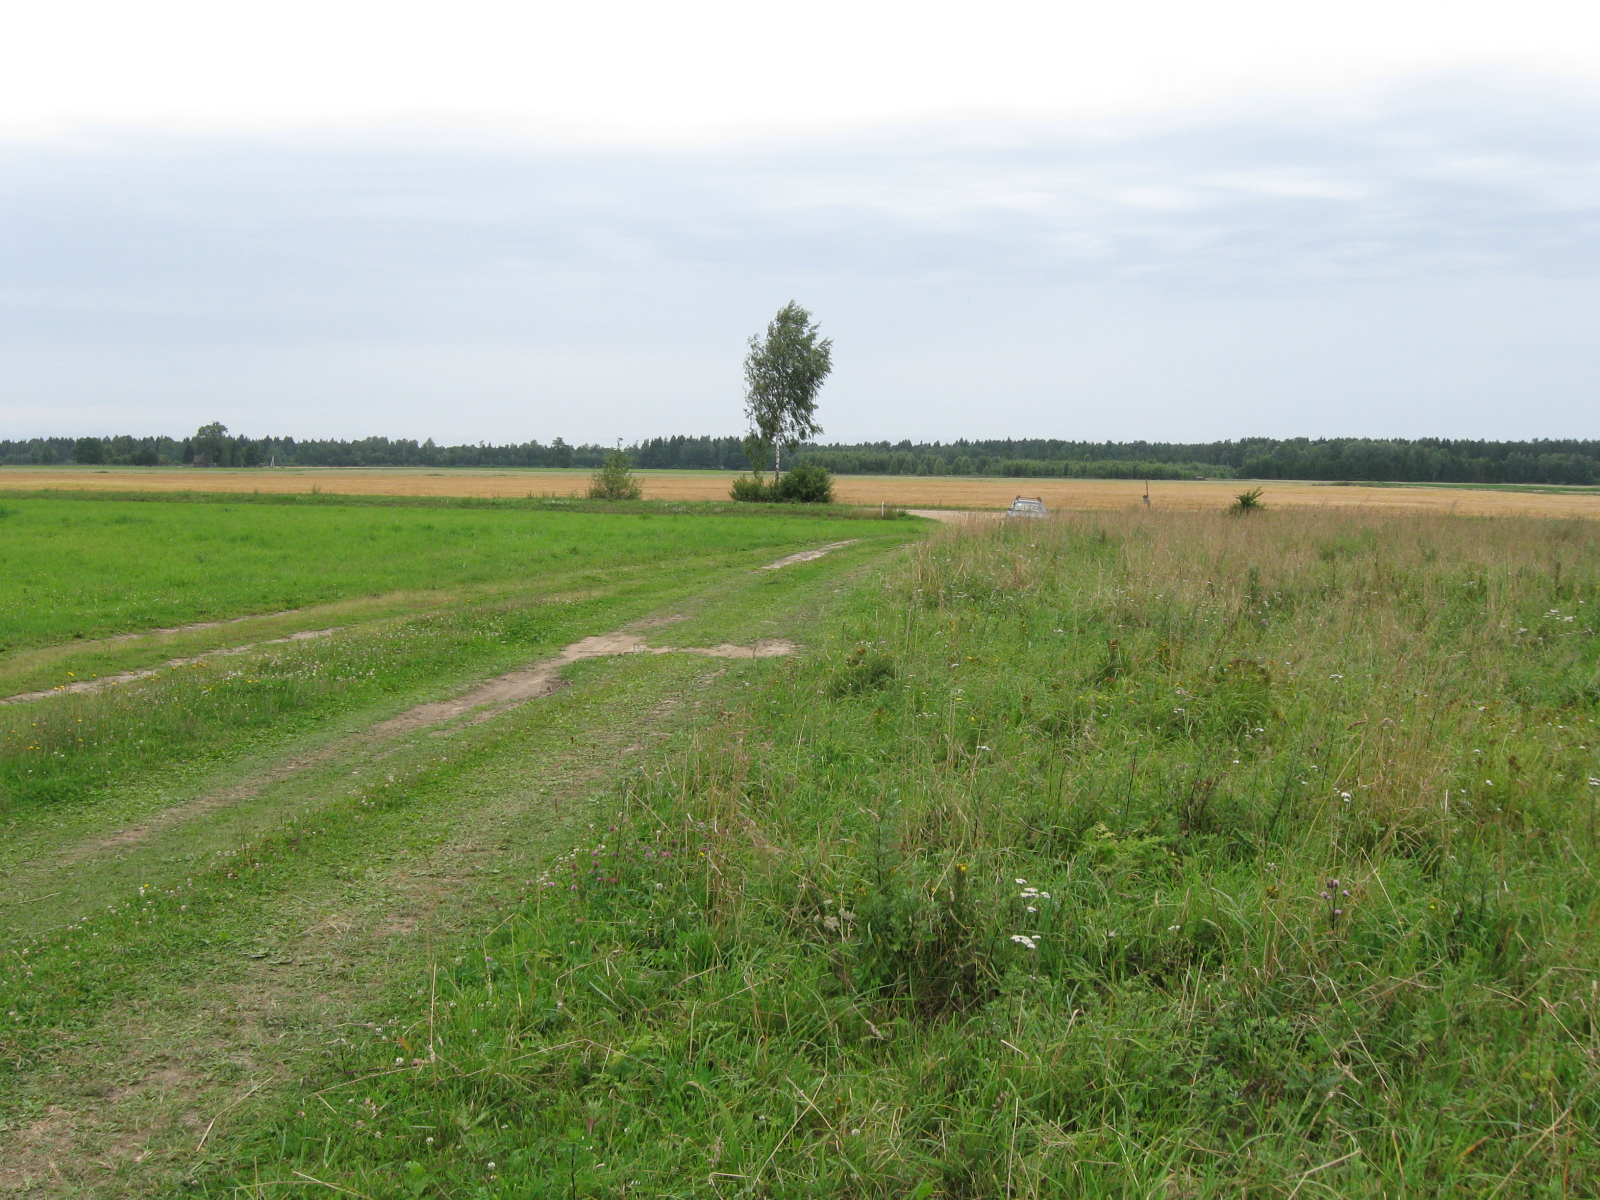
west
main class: Grassland
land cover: Grassland without tree/shrub cover
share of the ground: > 75 %
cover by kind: herbaceous plants 100 %
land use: Agriculture (excluding fallow land and kitchen gardens)
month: July
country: LT
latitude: 54.8618
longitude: 23.7173
